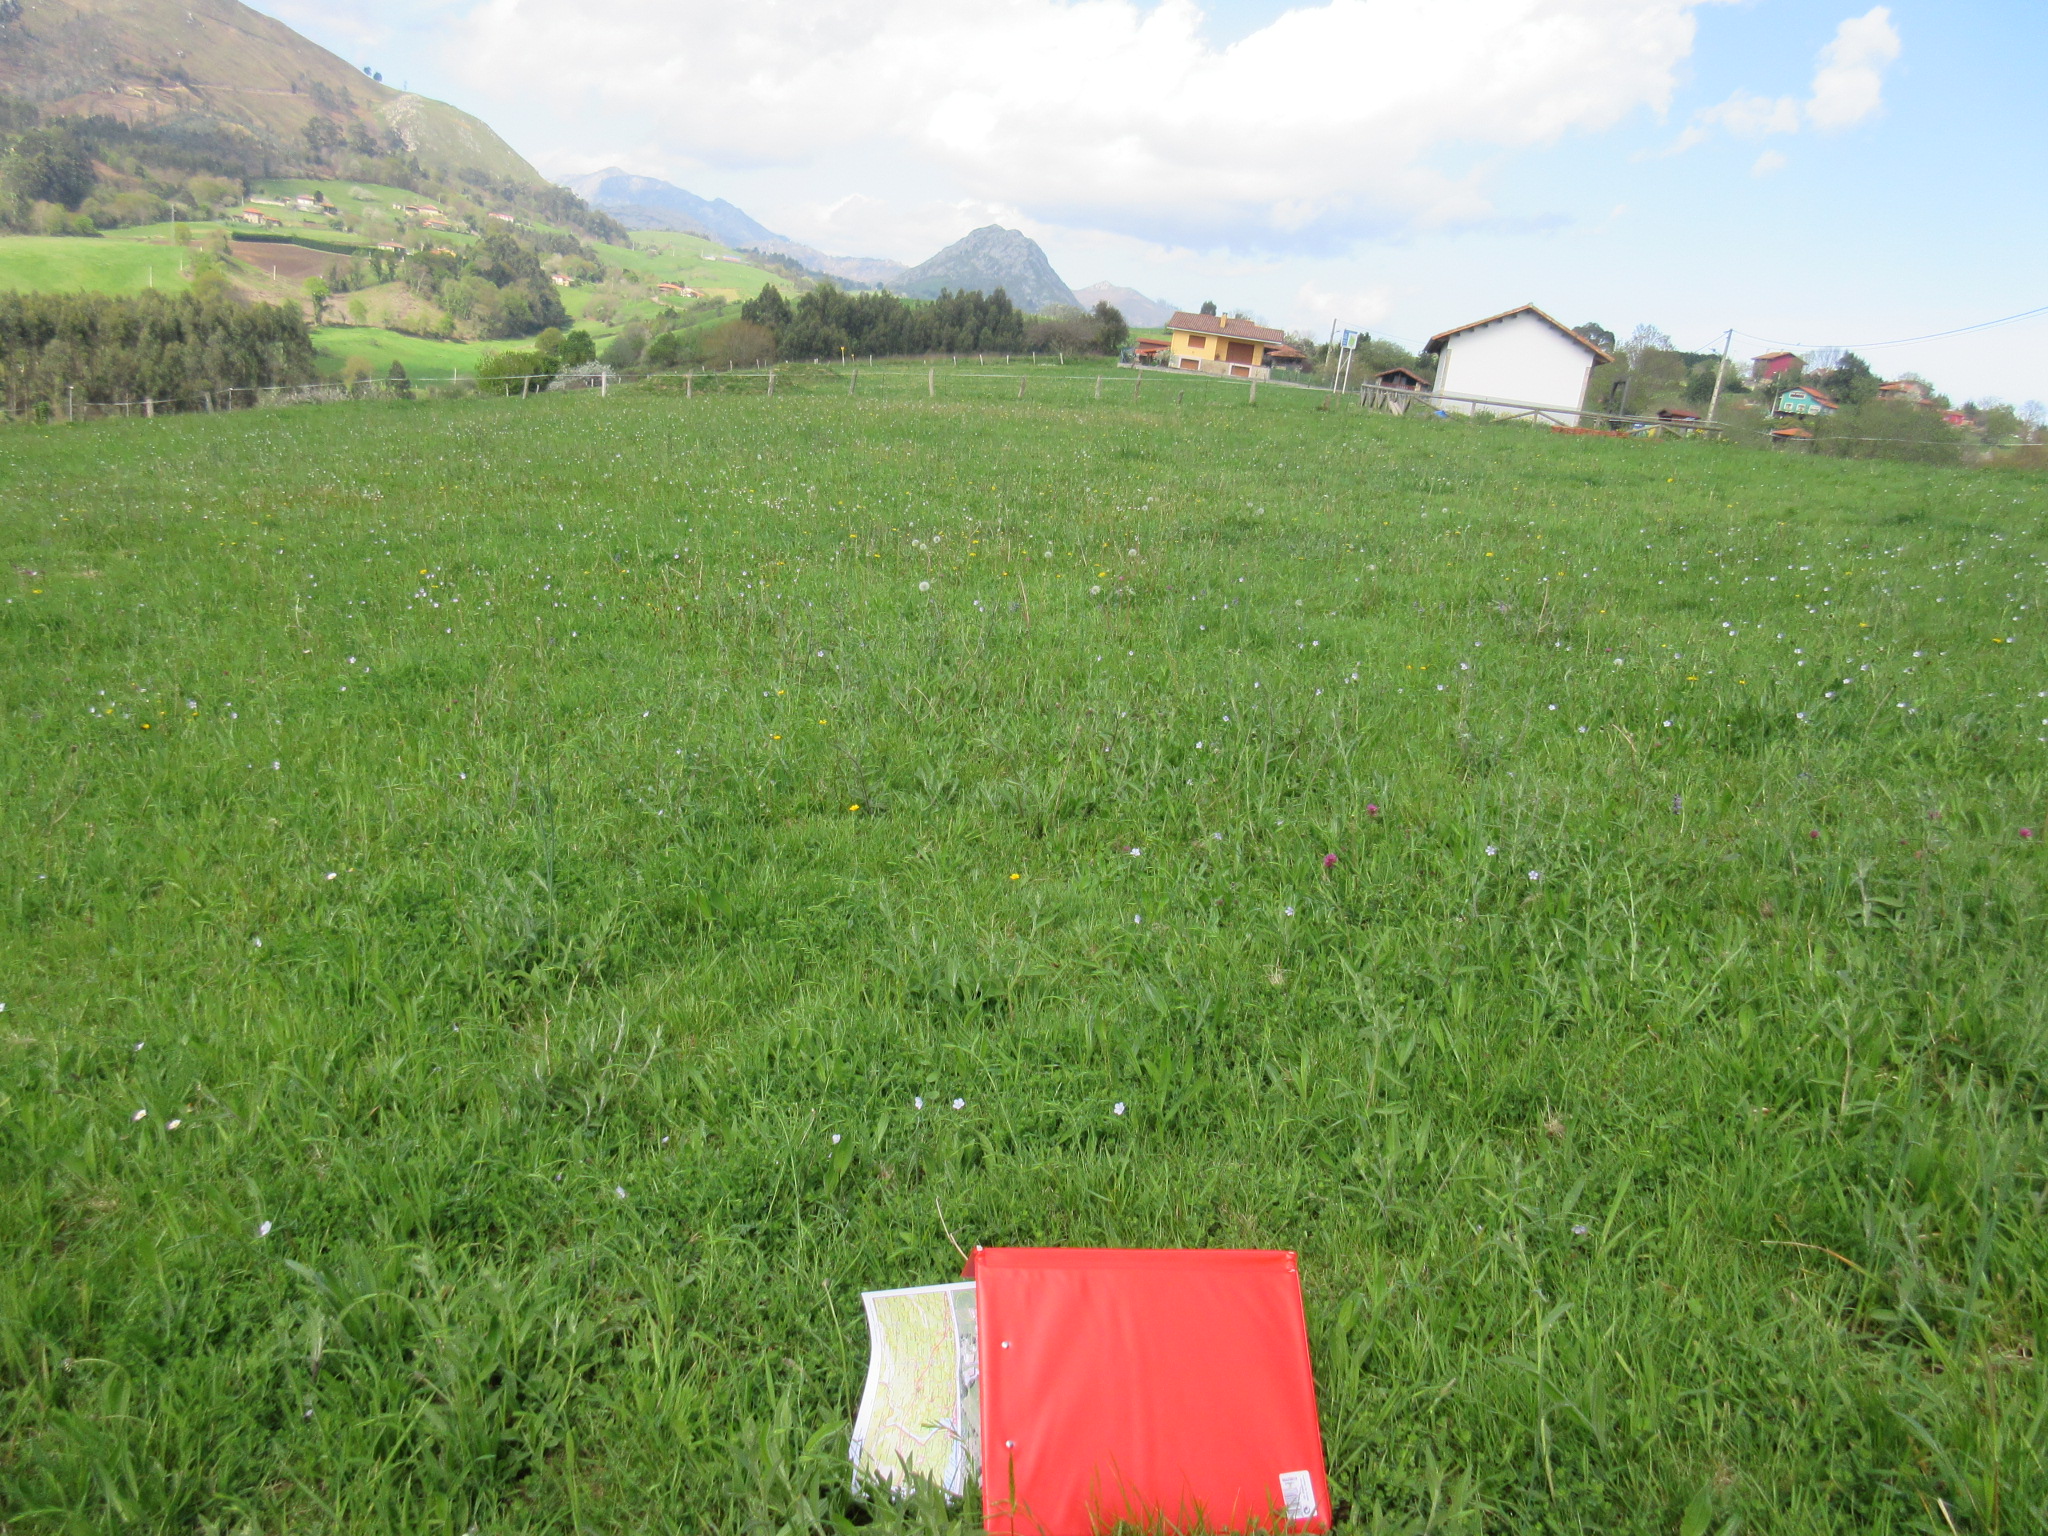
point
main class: Grassland
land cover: Grassland without tree/shrub cover
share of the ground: > 75 %
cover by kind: herbaceous plants 100 %
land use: Agriculture (excluding fallow land and kitchen gardens)
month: April
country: ES
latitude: 43.4419
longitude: -5.0844
